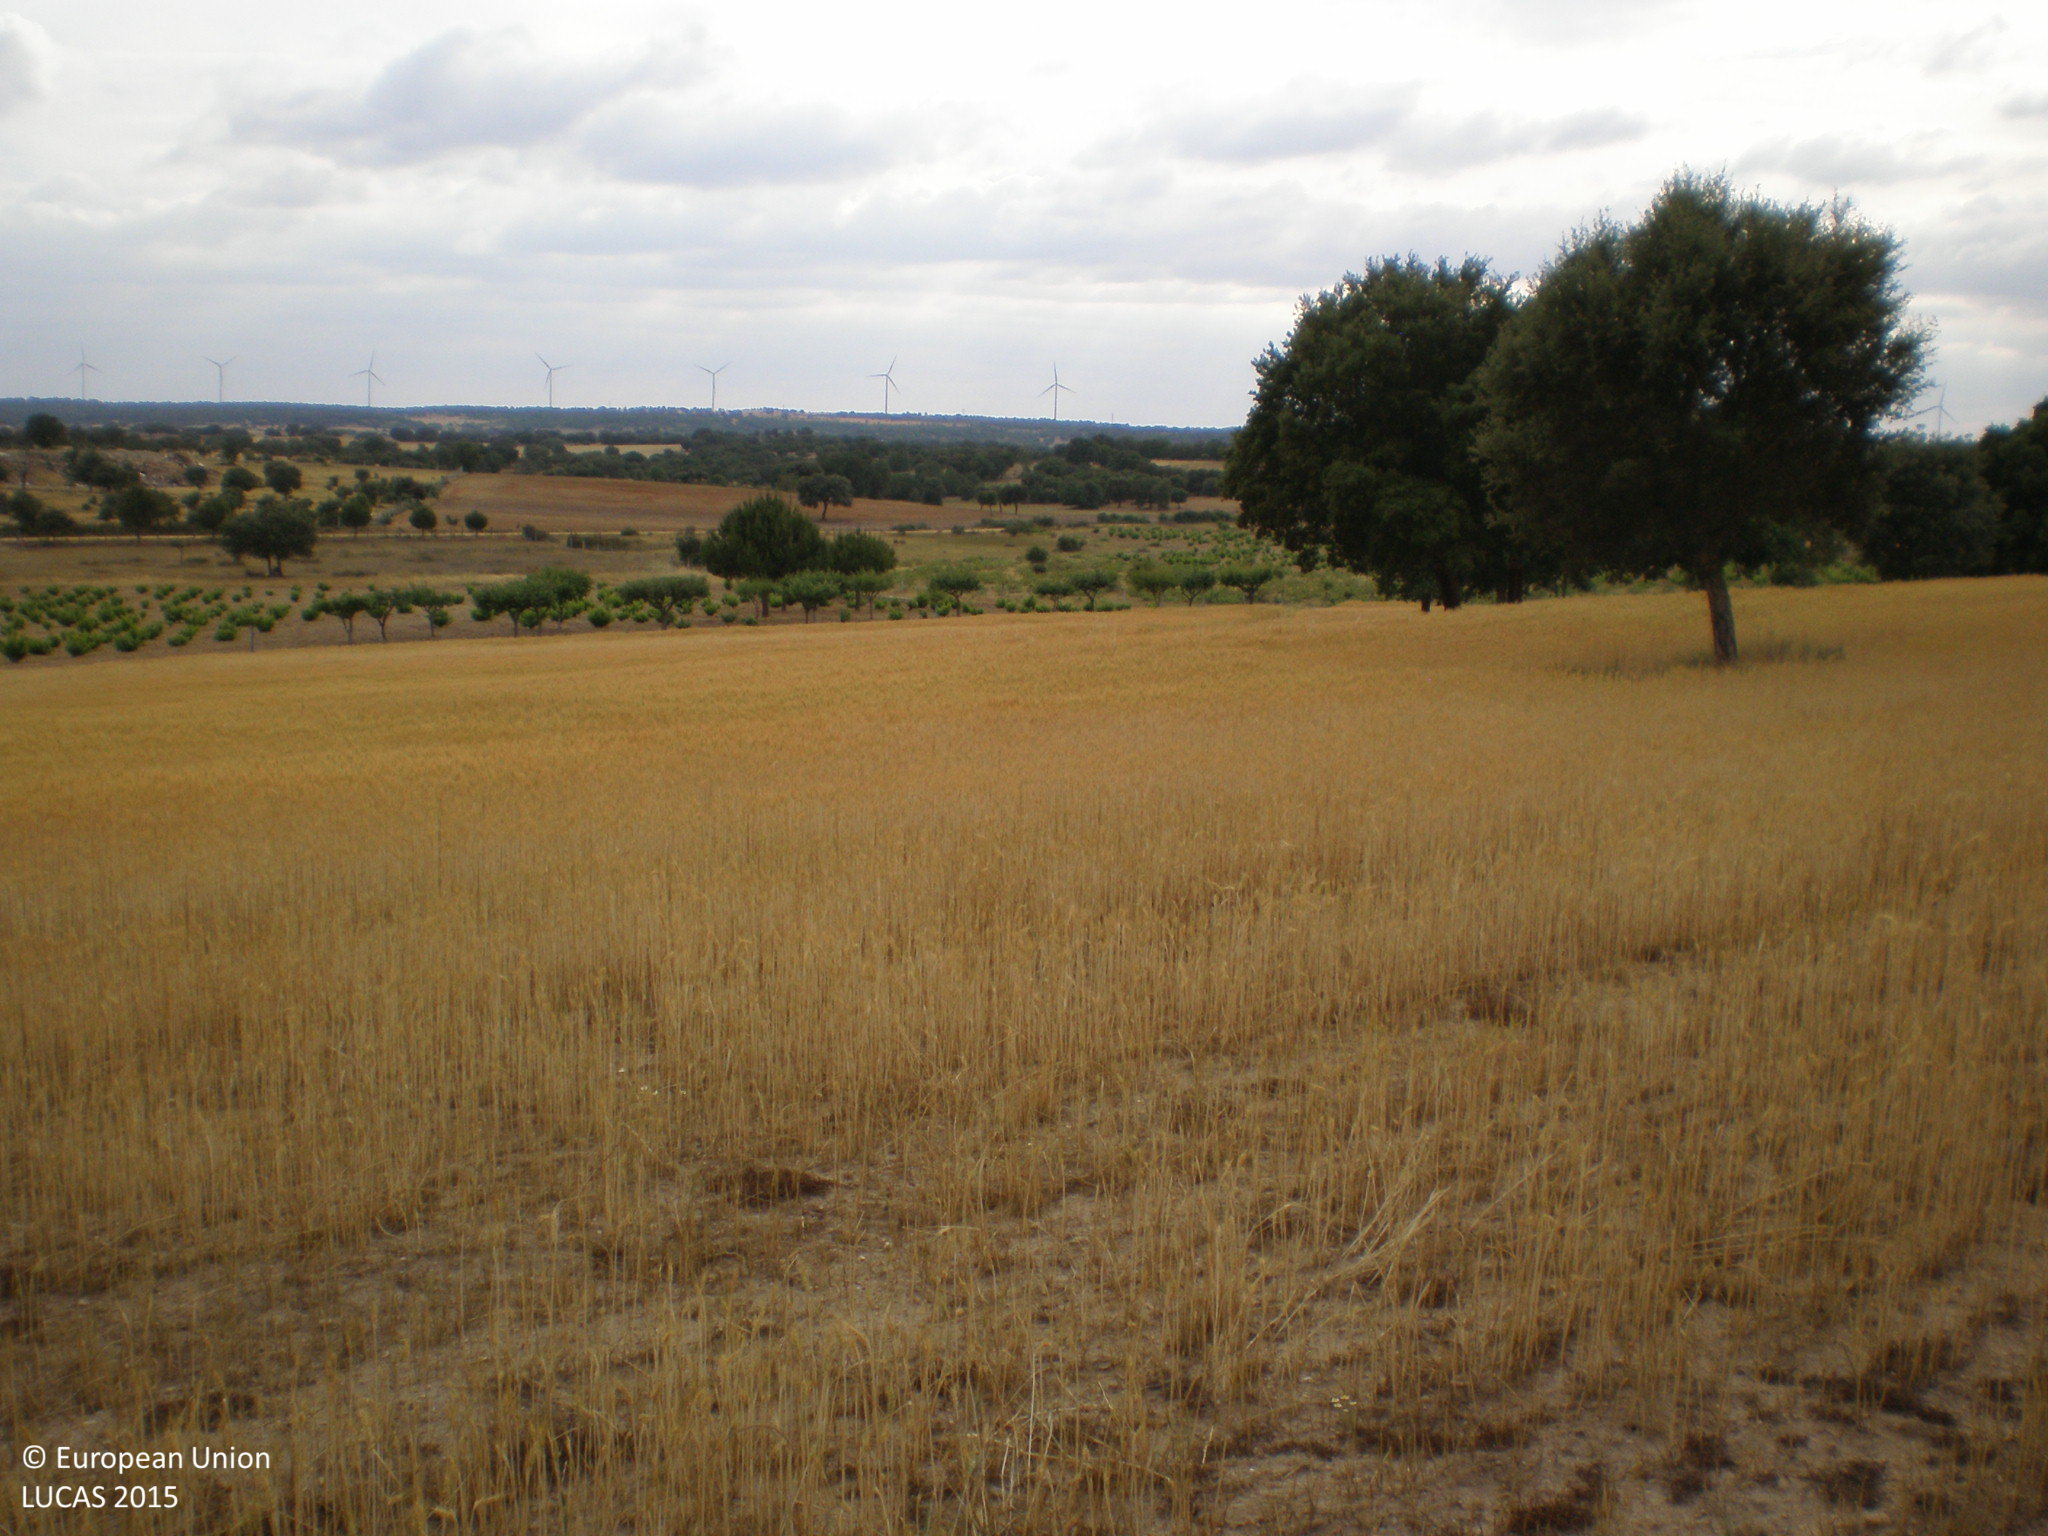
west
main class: Cropland
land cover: Triticale
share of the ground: > 75 %
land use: Agriculture (excluding fallow land and kitchen gardens)
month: June
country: ES
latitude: 41.1654
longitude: -5.8032
